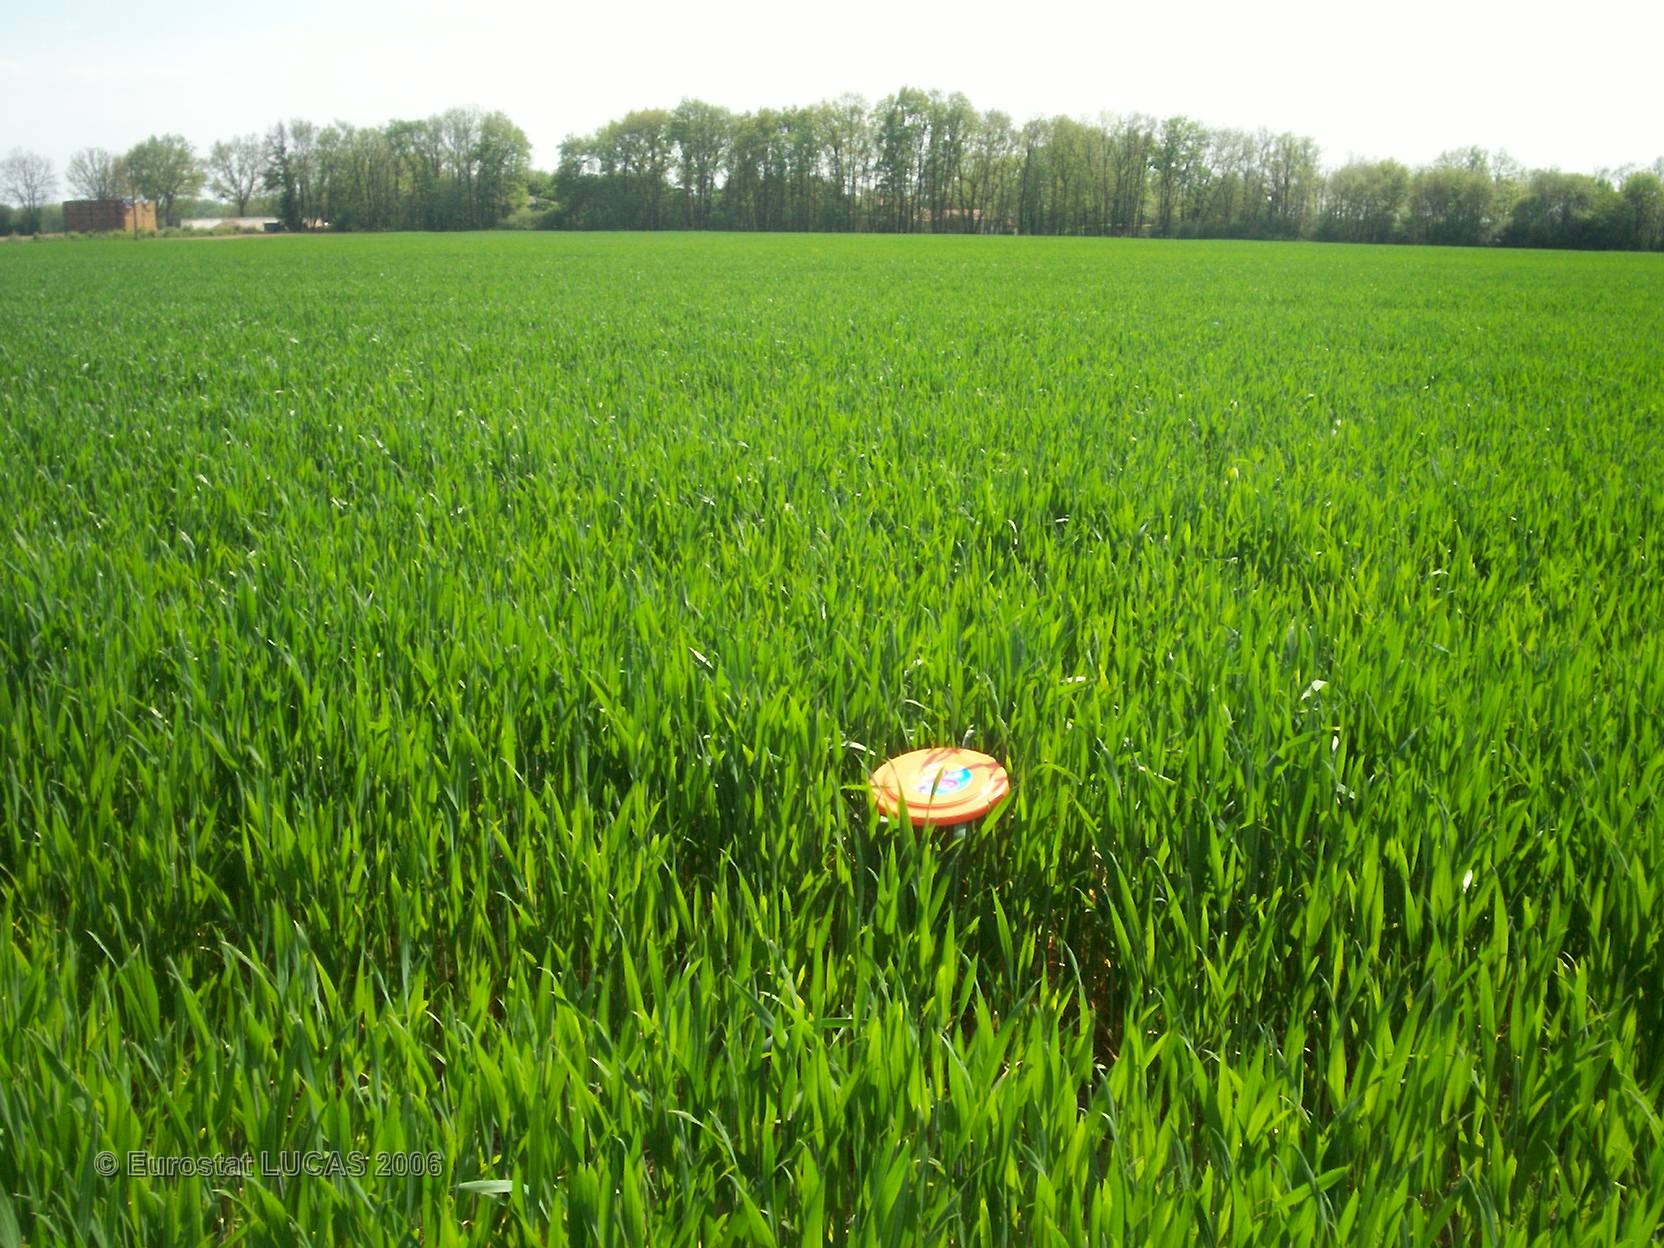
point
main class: Cropland
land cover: Common wheat
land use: Agriculture (excluding fallow land and kitchen gardens)
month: May
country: FR
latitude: 46.5061
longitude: 0.4823
